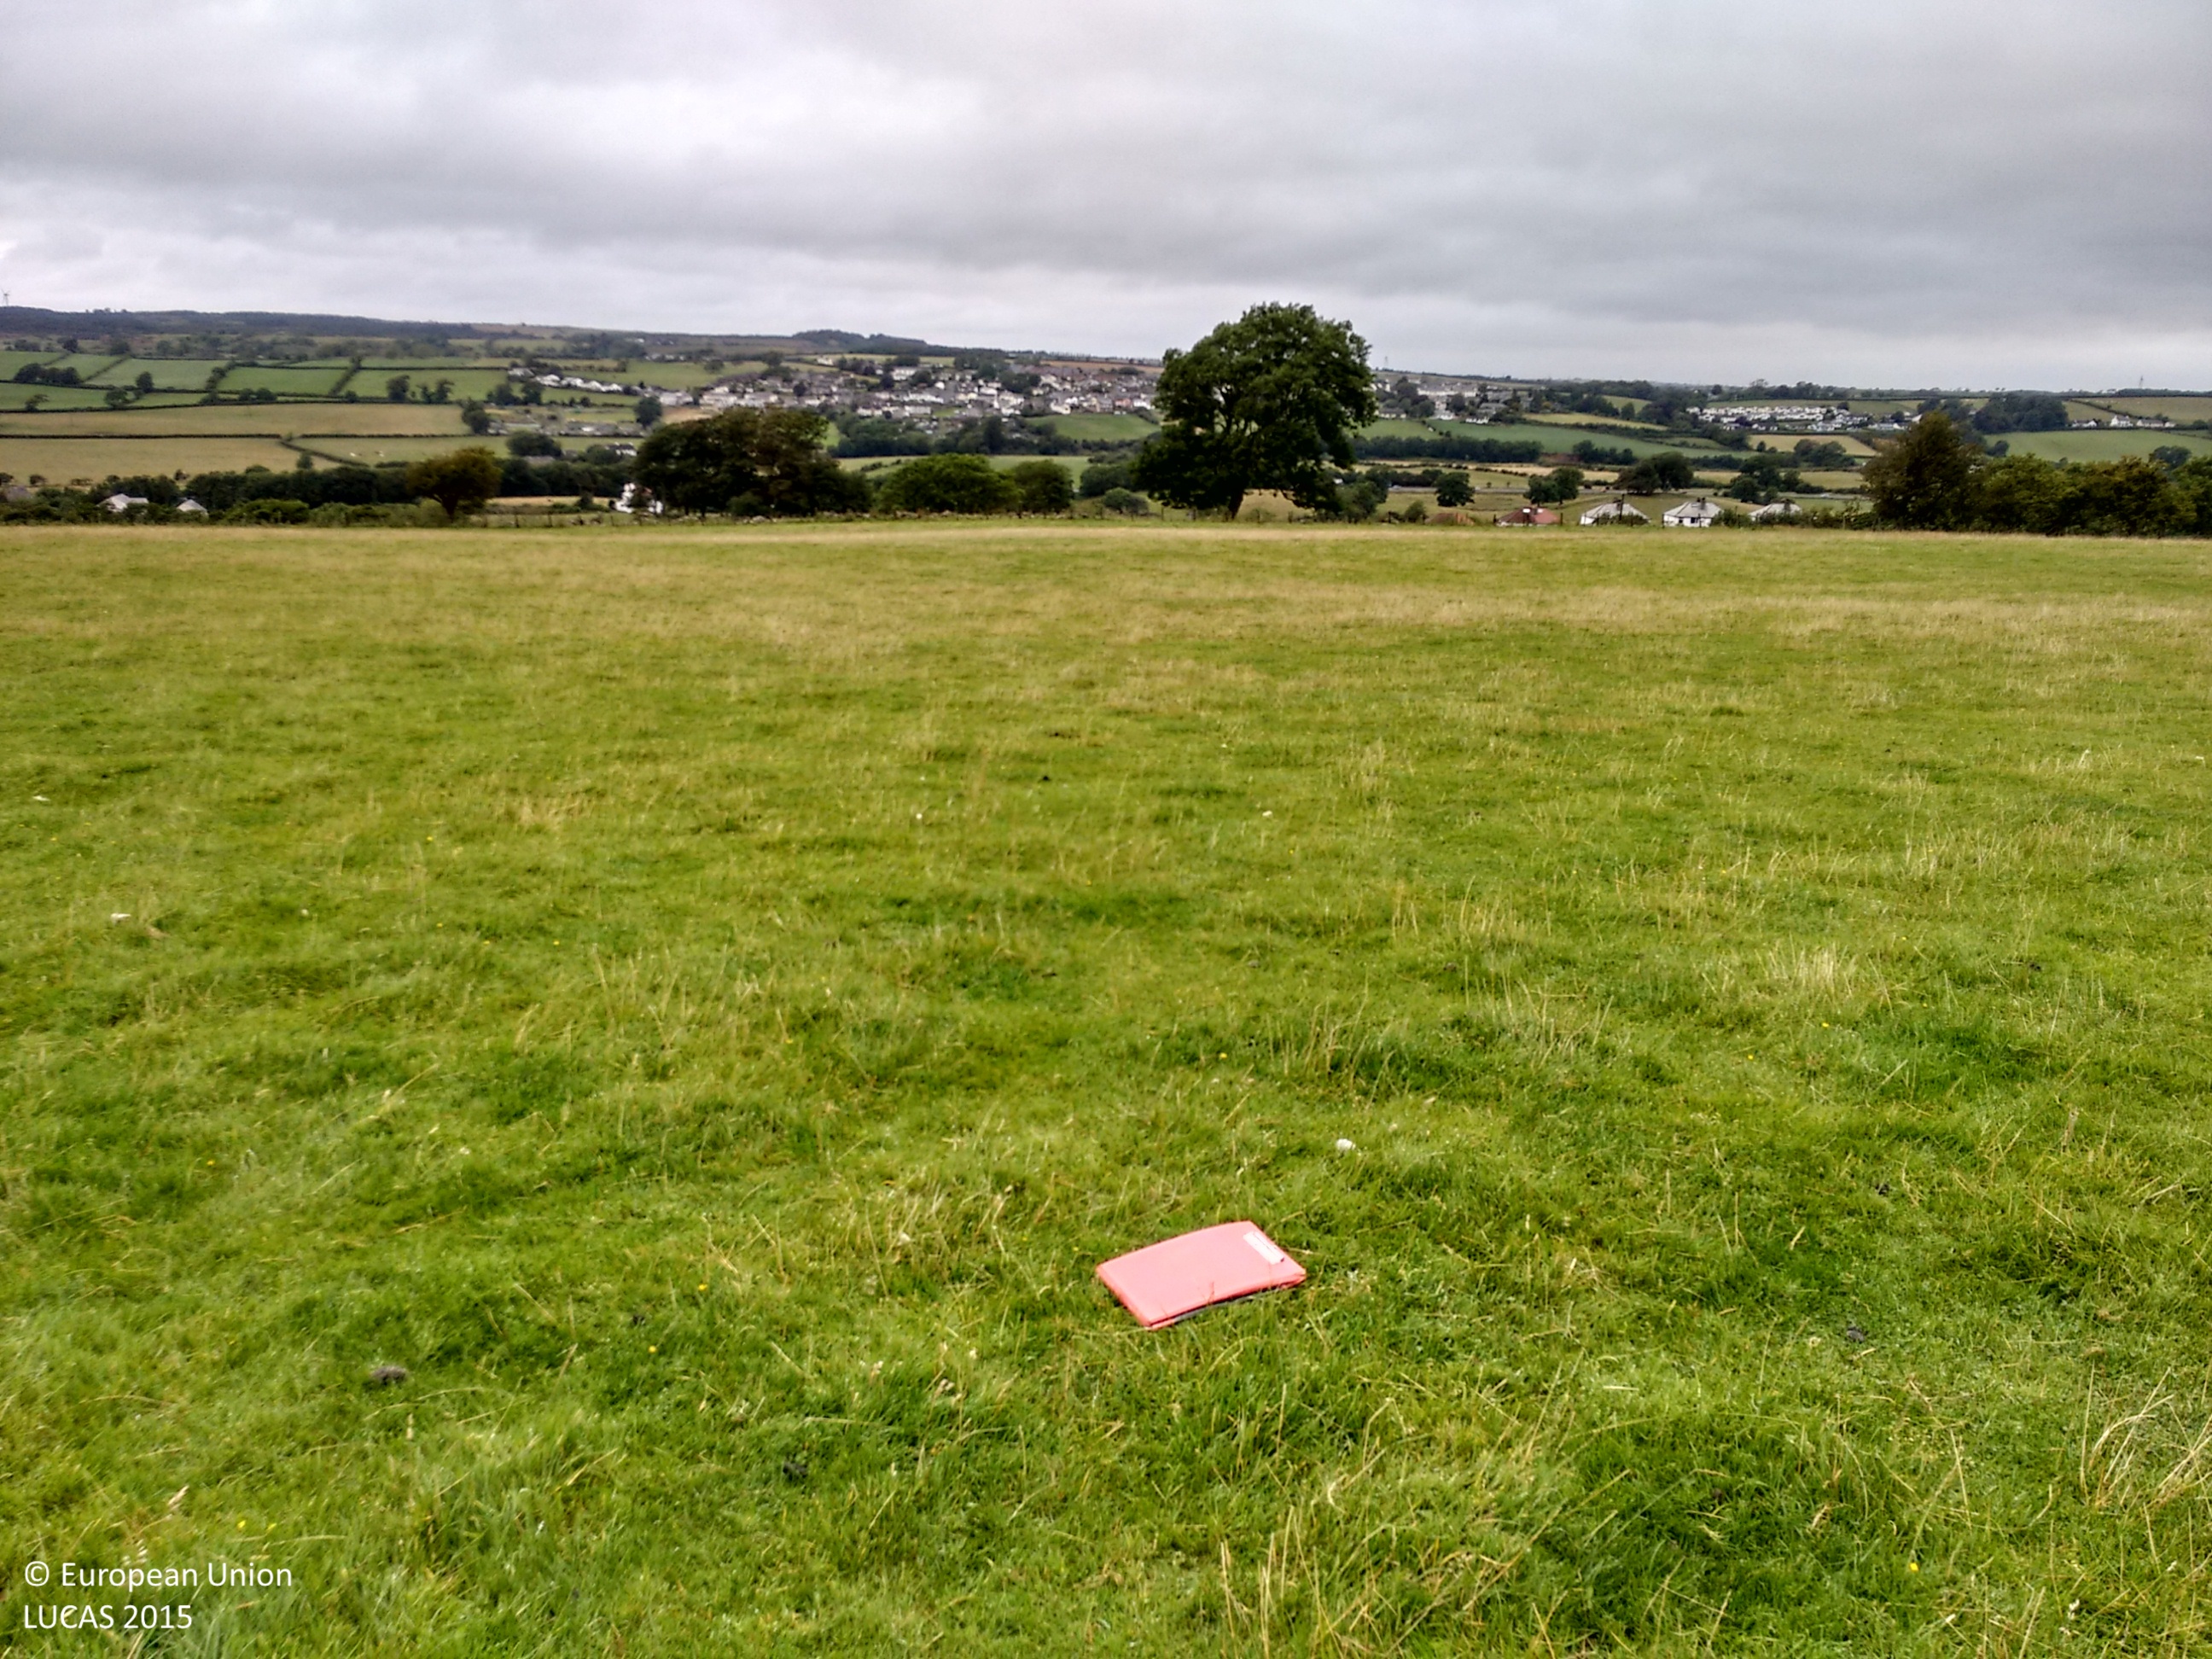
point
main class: Grassland
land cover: Grassland without tree/shrub cover
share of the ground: > 75 %
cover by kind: herbaceous plants 100 %
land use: Agriculture (excluding fallow land and kitchen gardens)
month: August
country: GB
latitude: 54.6565
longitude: -3.4262
